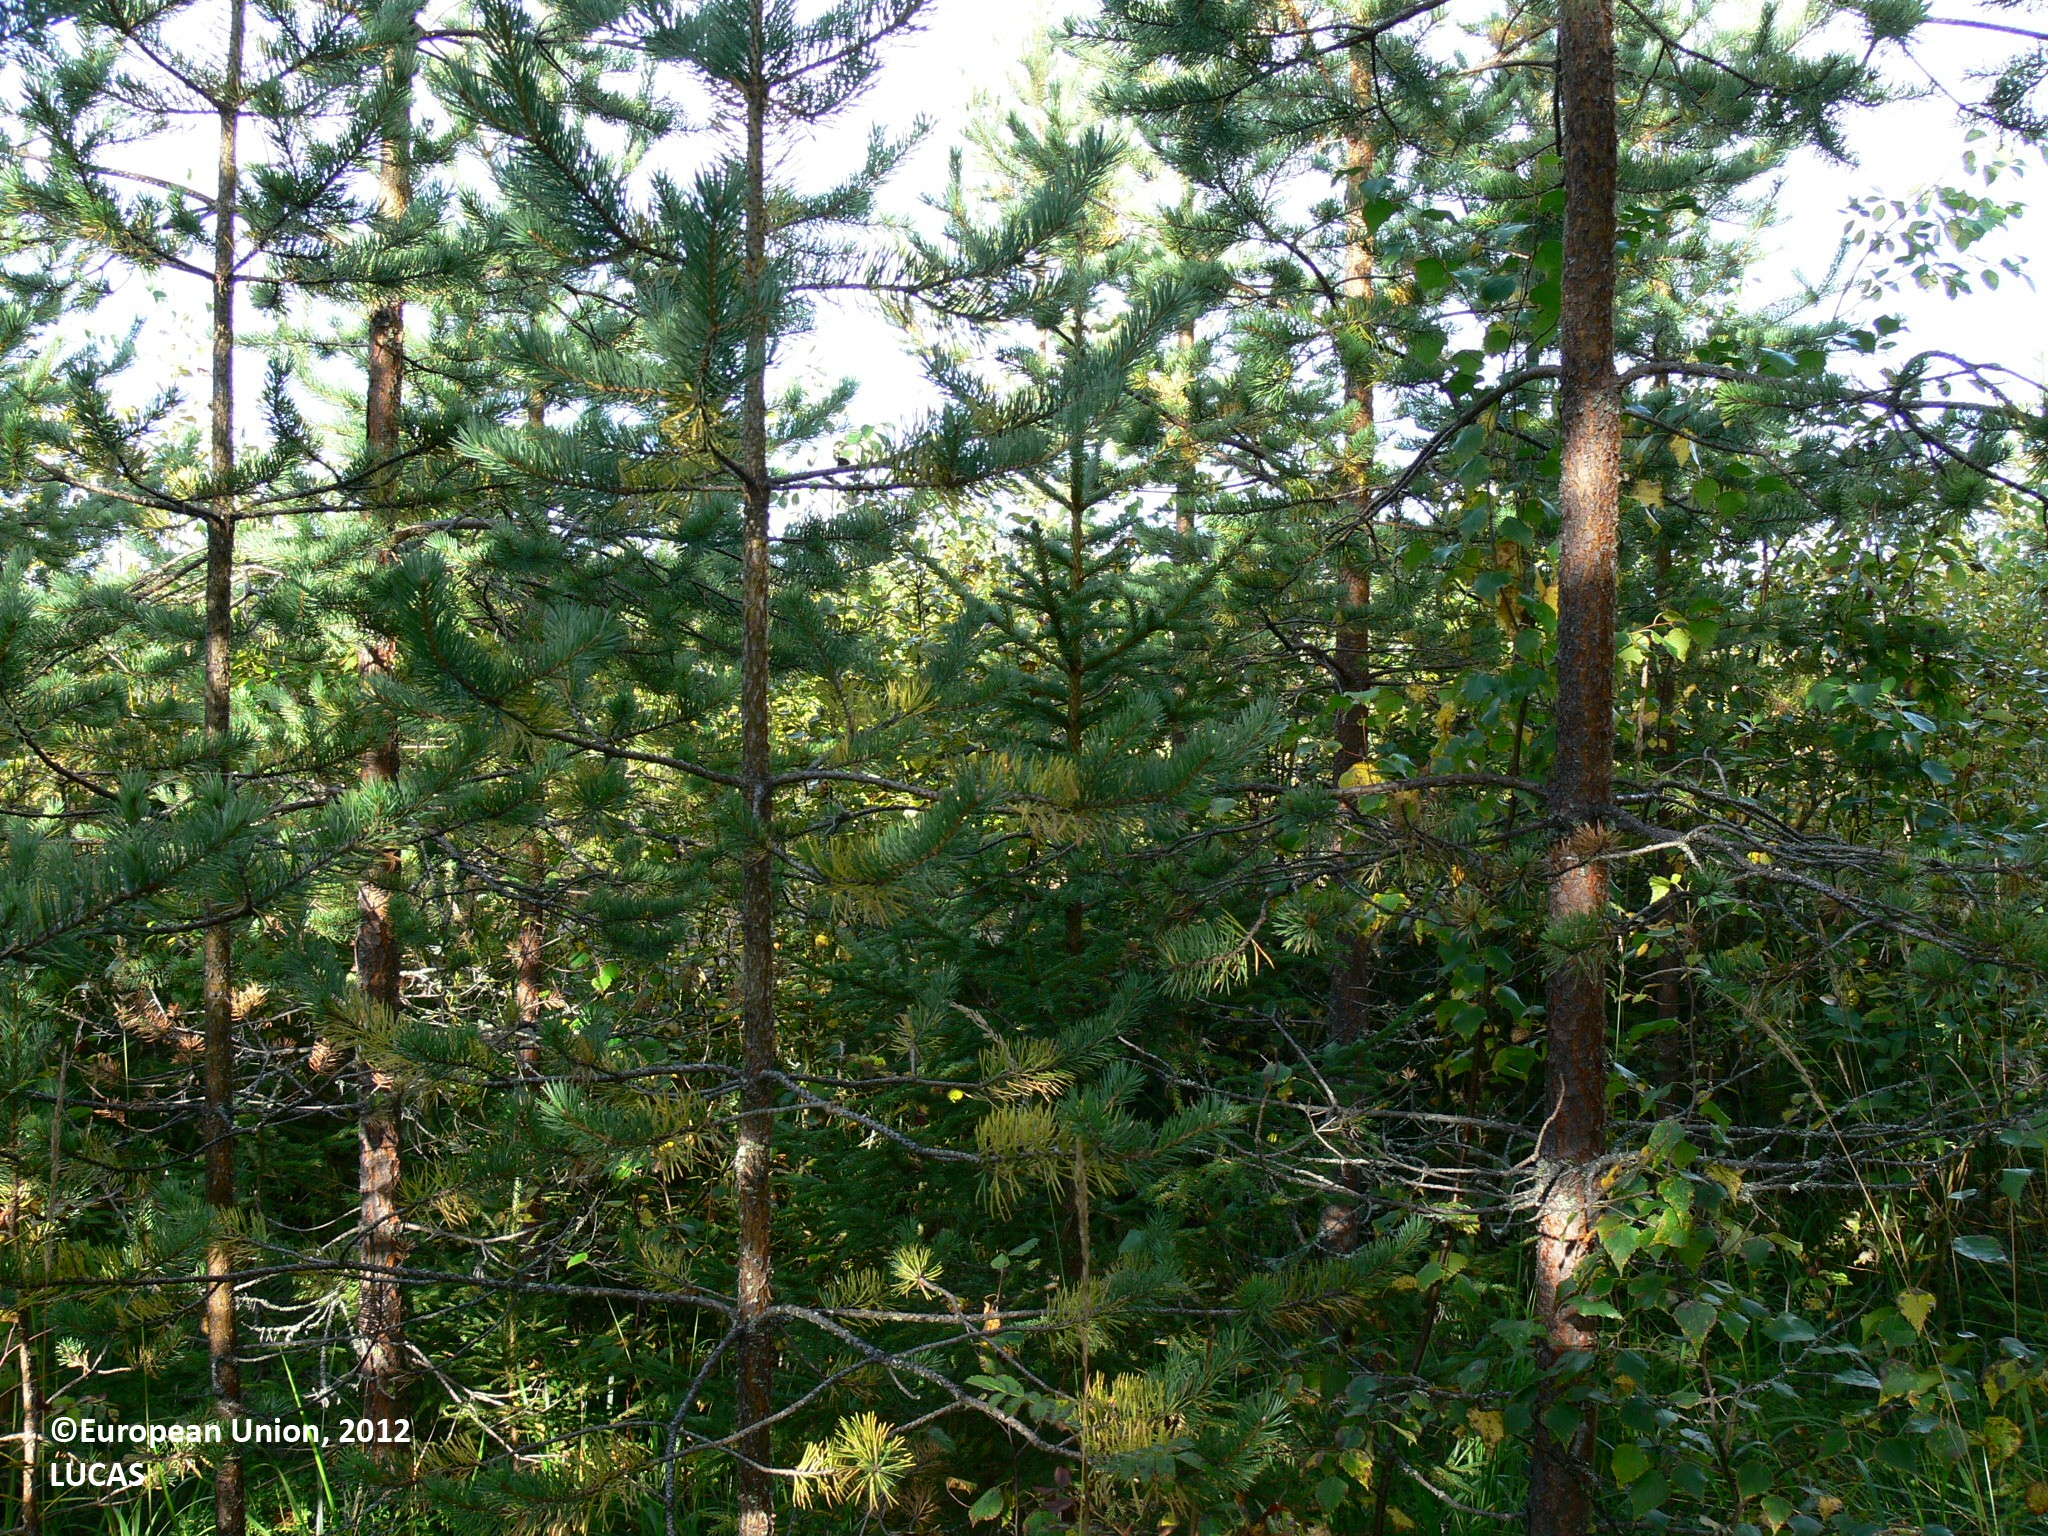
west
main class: Woodland
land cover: Pine dominated coniferous woodland
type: boreal forest
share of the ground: 50 - 75 %
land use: Forestry
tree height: < 5 m
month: September
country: FI
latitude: 63.1986
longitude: 30.1156
